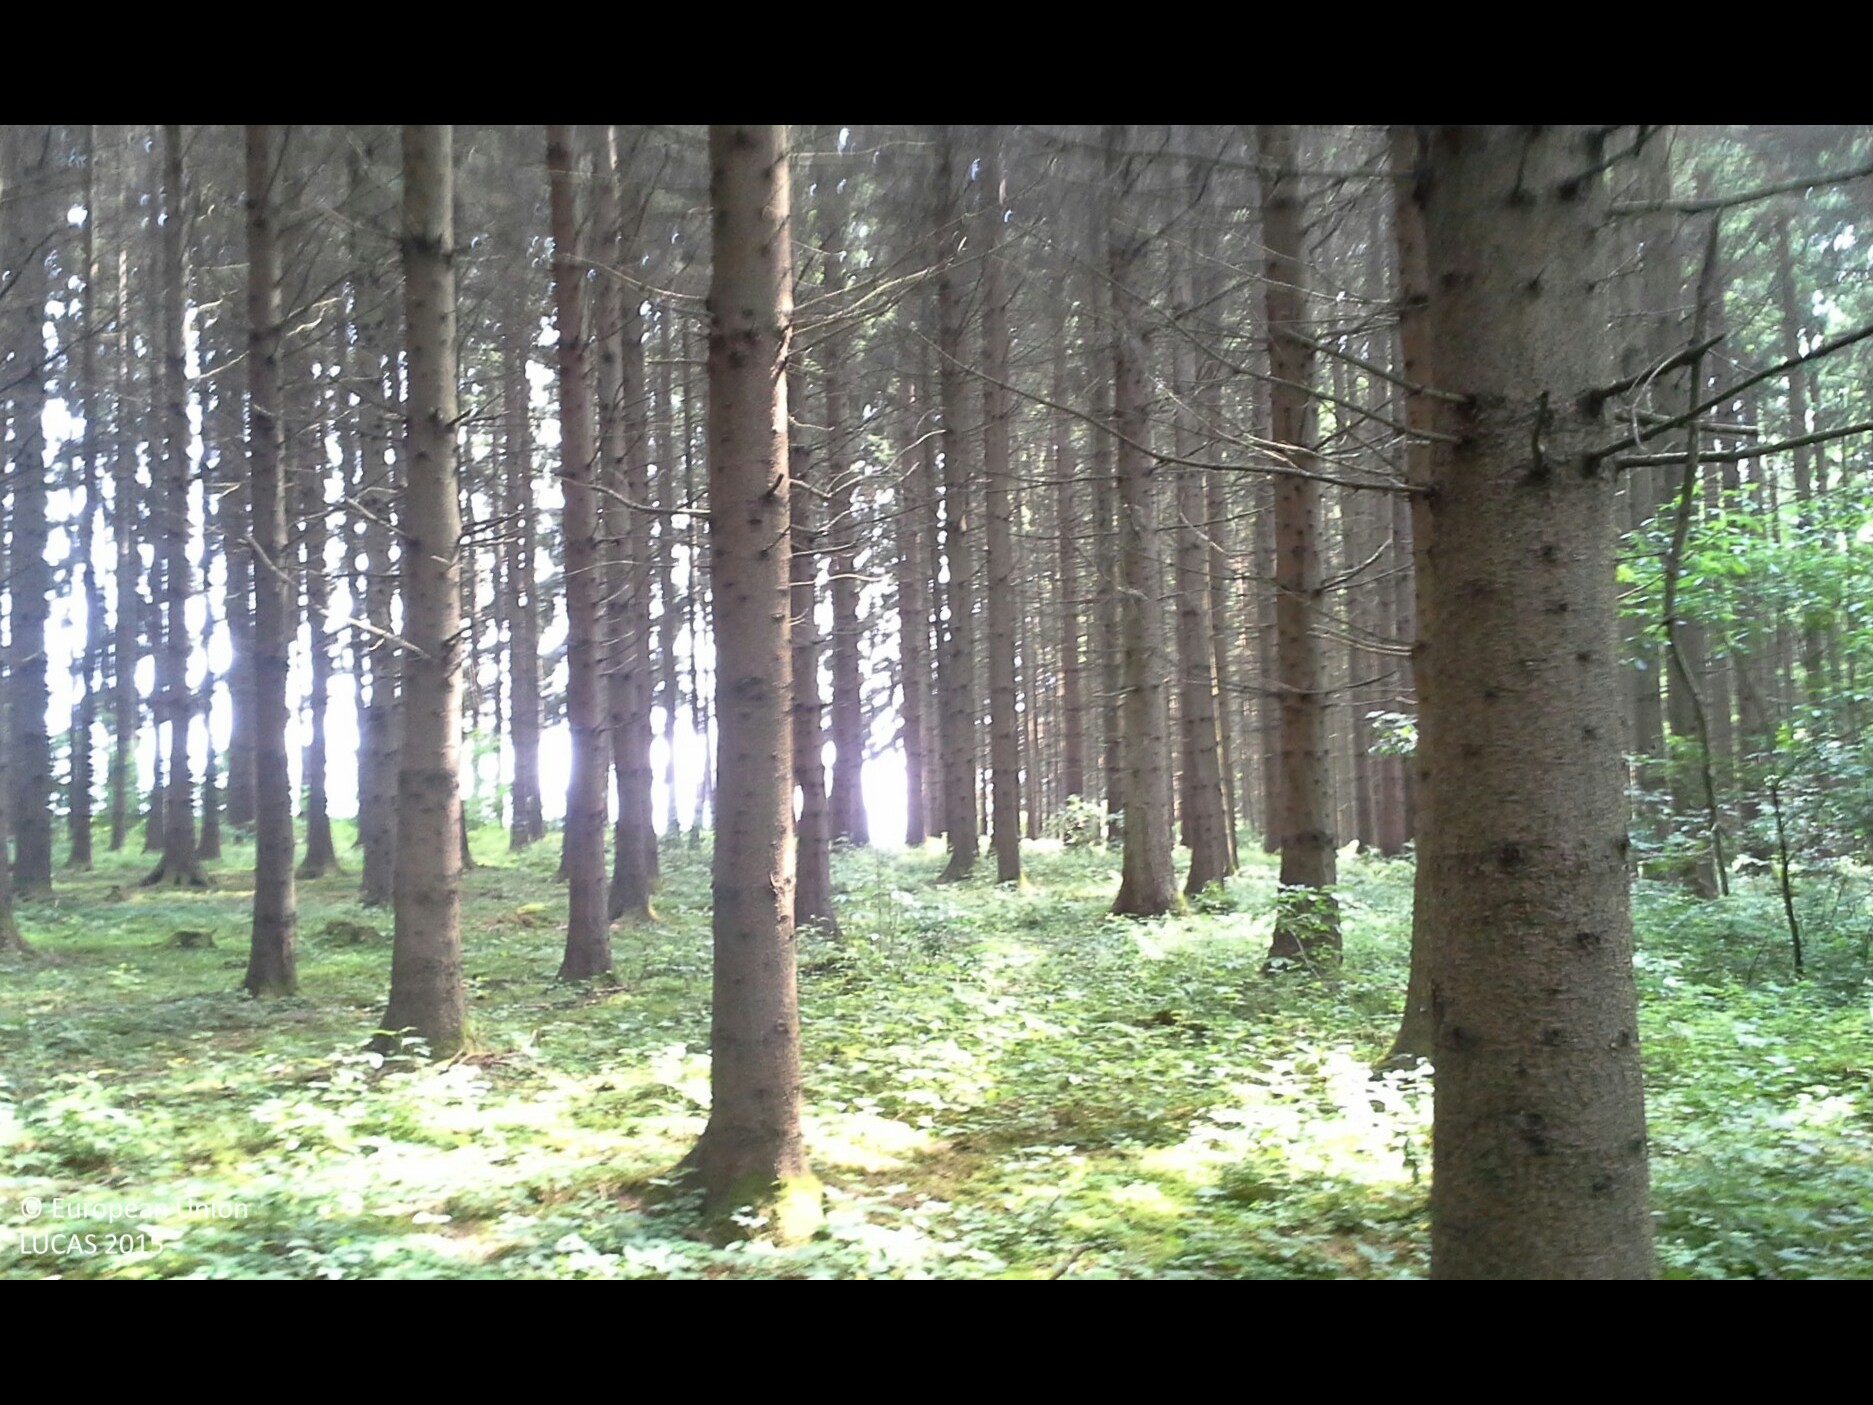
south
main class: Woodland
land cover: Spruce dominated coniferous woodland
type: hemiboreal forest and nemoral coniferous forest and mixed broadleaved-coniferous forest
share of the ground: > 75 %
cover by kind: coniferous forest trees 100 %
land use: Forestry
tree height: > 5 m
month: June
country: AT
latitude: 48.0663
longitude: 14.3345
